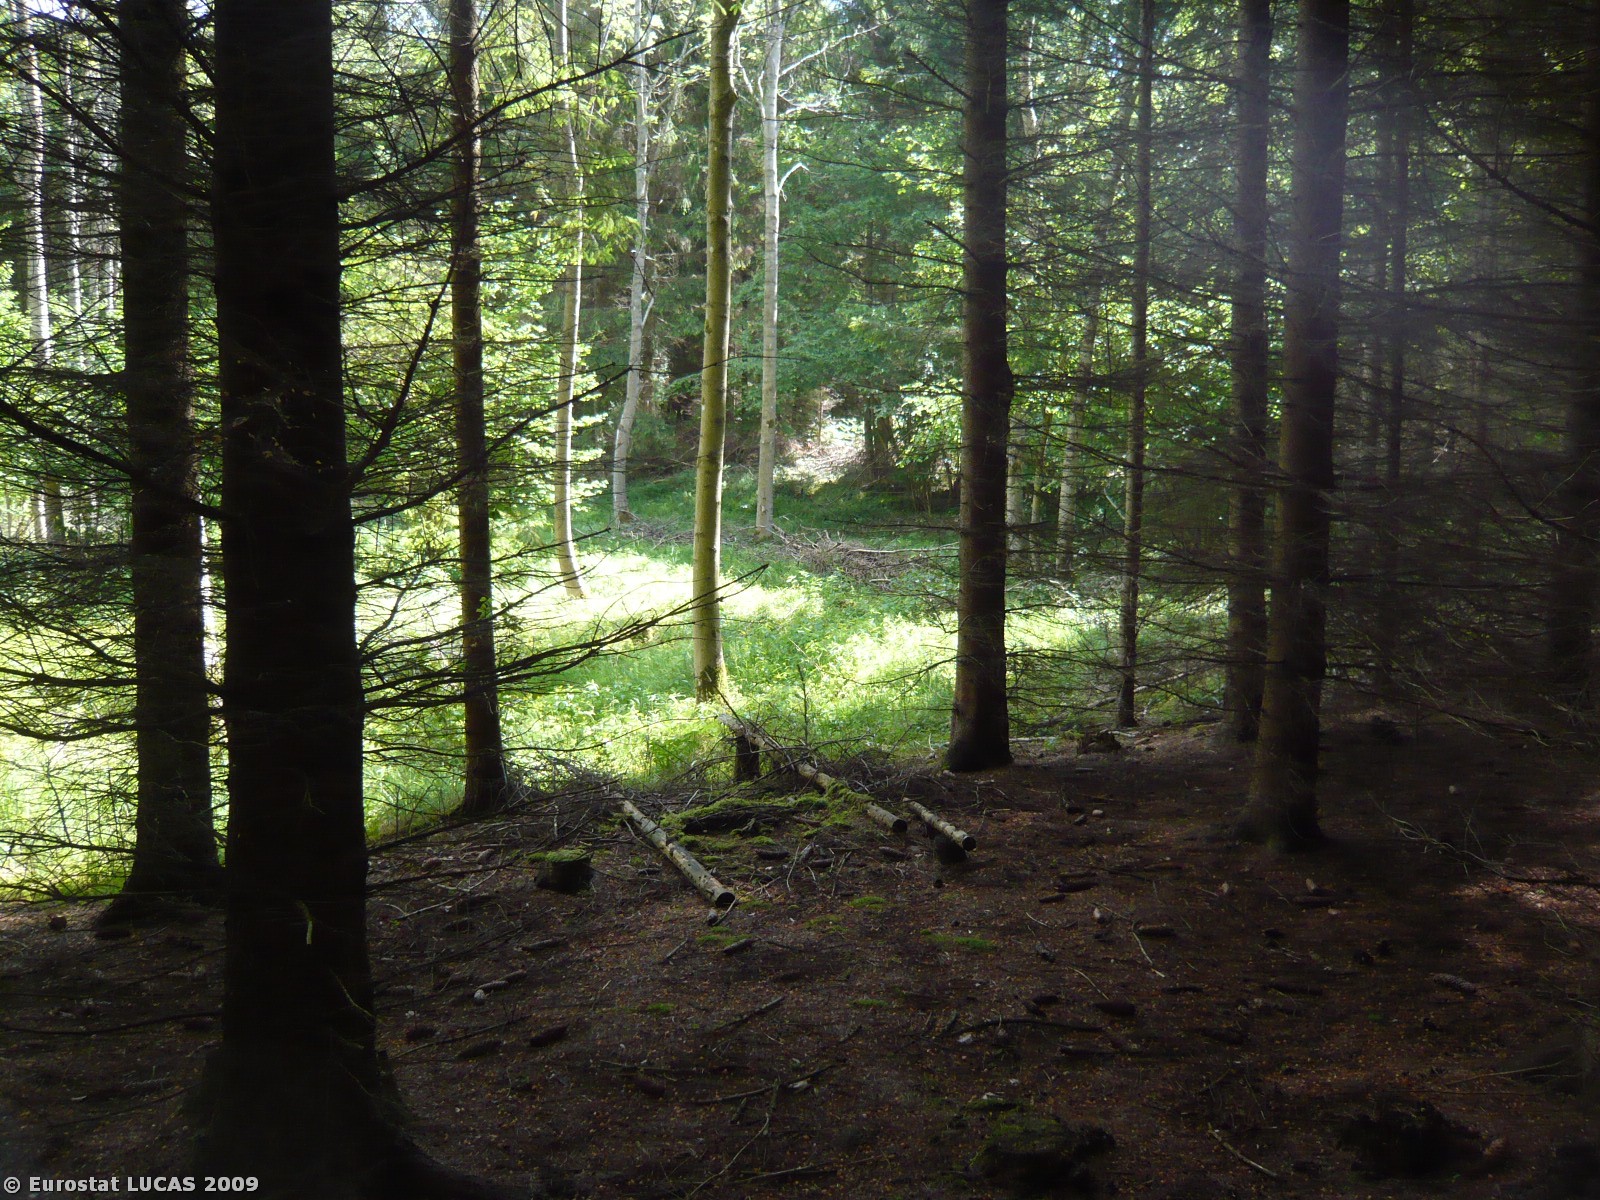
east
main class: Woodland
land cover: Coniferous woodland
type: hemiboreal forest and nemoral coniferous forest and mixed broadleaved-coniferous forest
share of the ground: > 75 %
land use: Forestry
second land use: Road transport
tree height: > 5 m
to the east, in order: Coniferous woodland; Broadleaved woodland; Tracks; Coniferous woodland; Broadleaved woodland; Ditches and canals; Broadleaved woodland
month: June
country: DK
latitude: 55.1888
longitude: 11.6166
